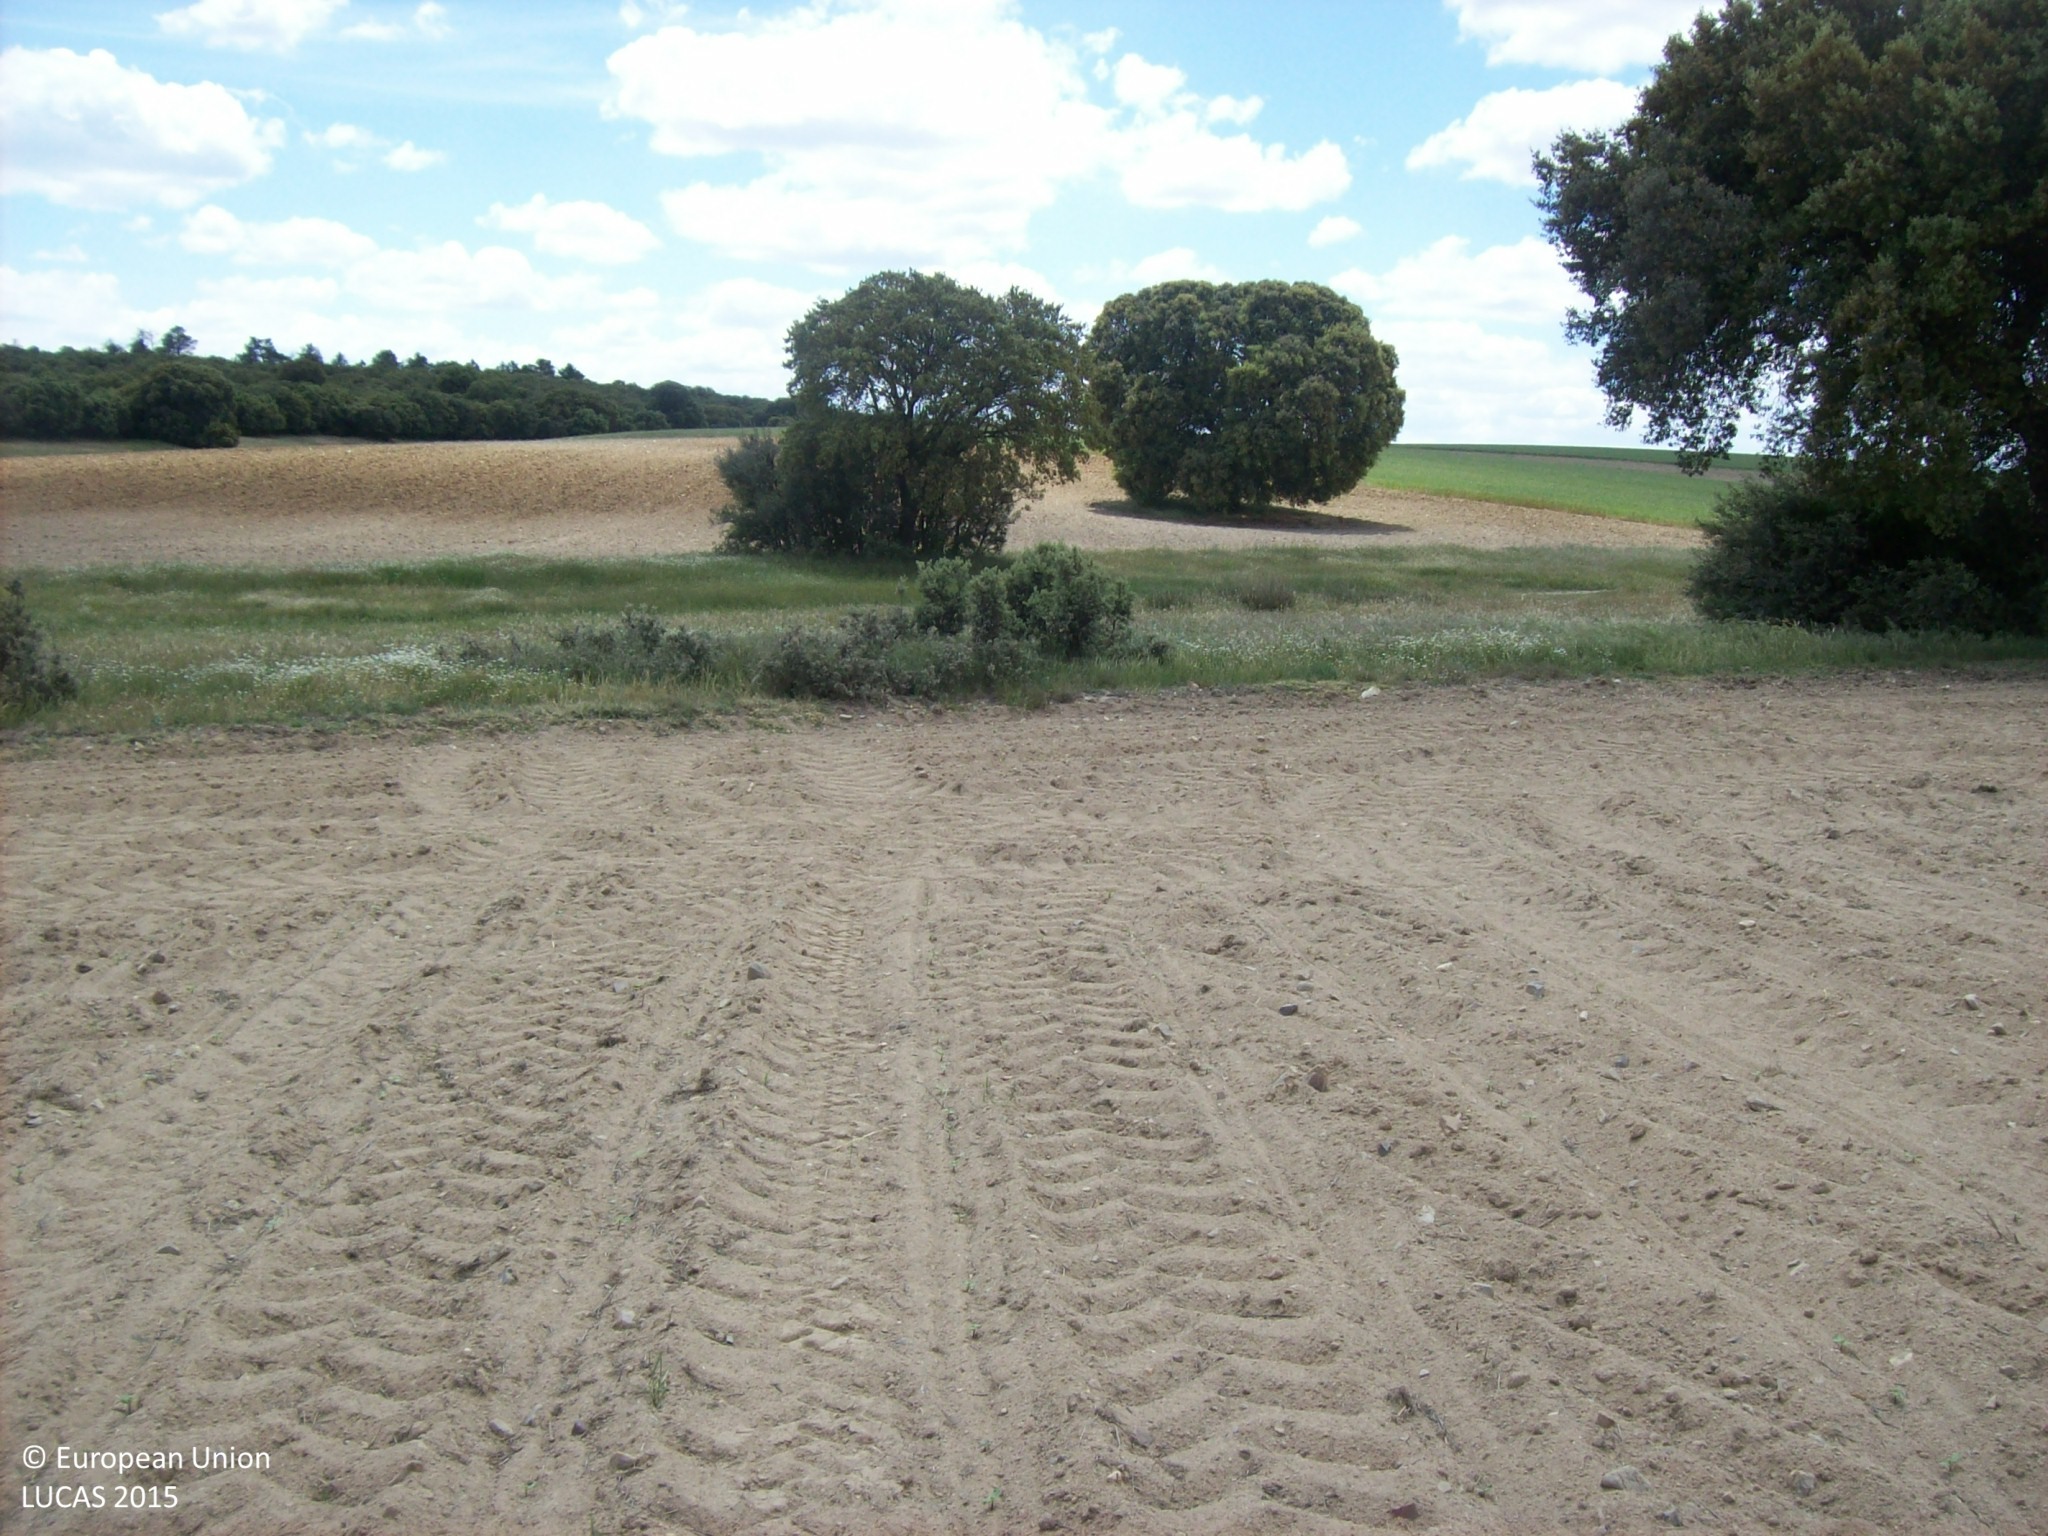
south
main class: Cropland
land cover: Sunflower
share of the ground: < 10 %
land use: Agriculture (excluding fallow land and kitchen gardens)
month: May
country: ES
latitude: 40.8753
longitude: -4.4722
